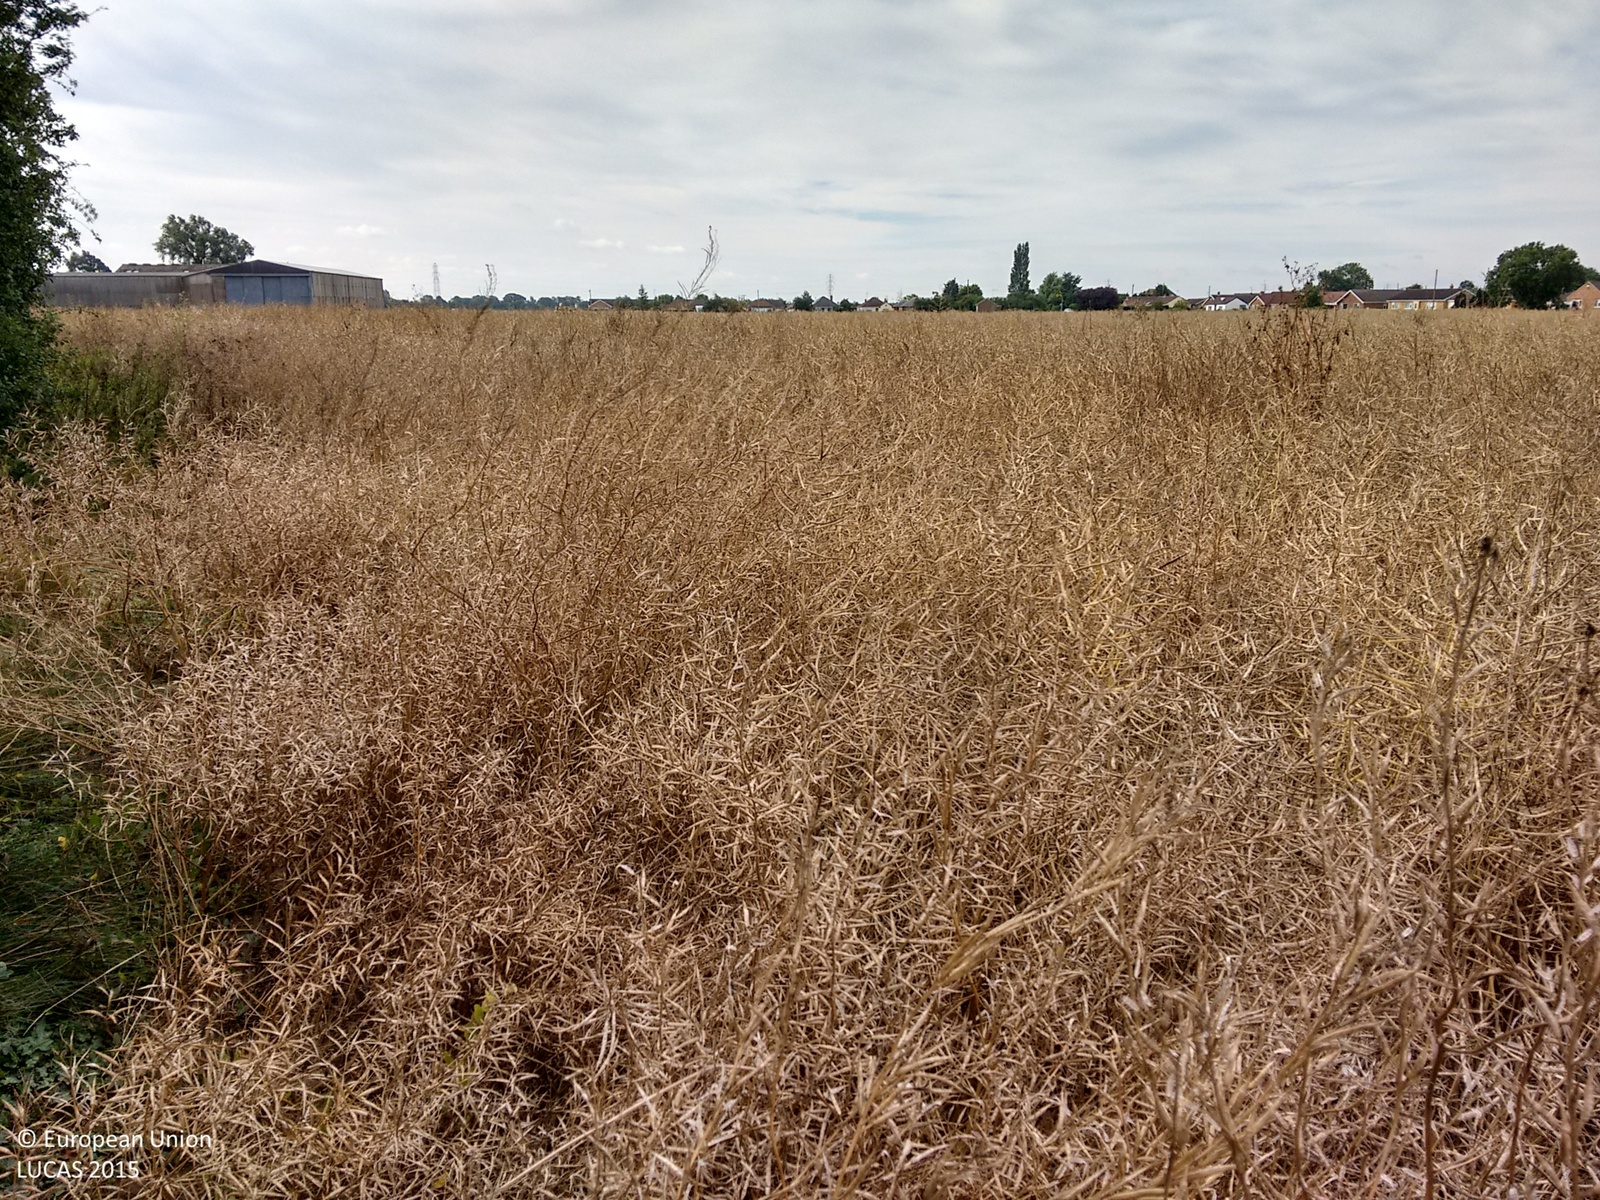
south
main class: Cropland
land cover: Rape and turnip rape
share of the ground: > 75 %
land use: Agriculture (excluding fallow land and kitchen gardens)
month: August
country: GB
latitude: 52.7601
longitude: 0.3241
